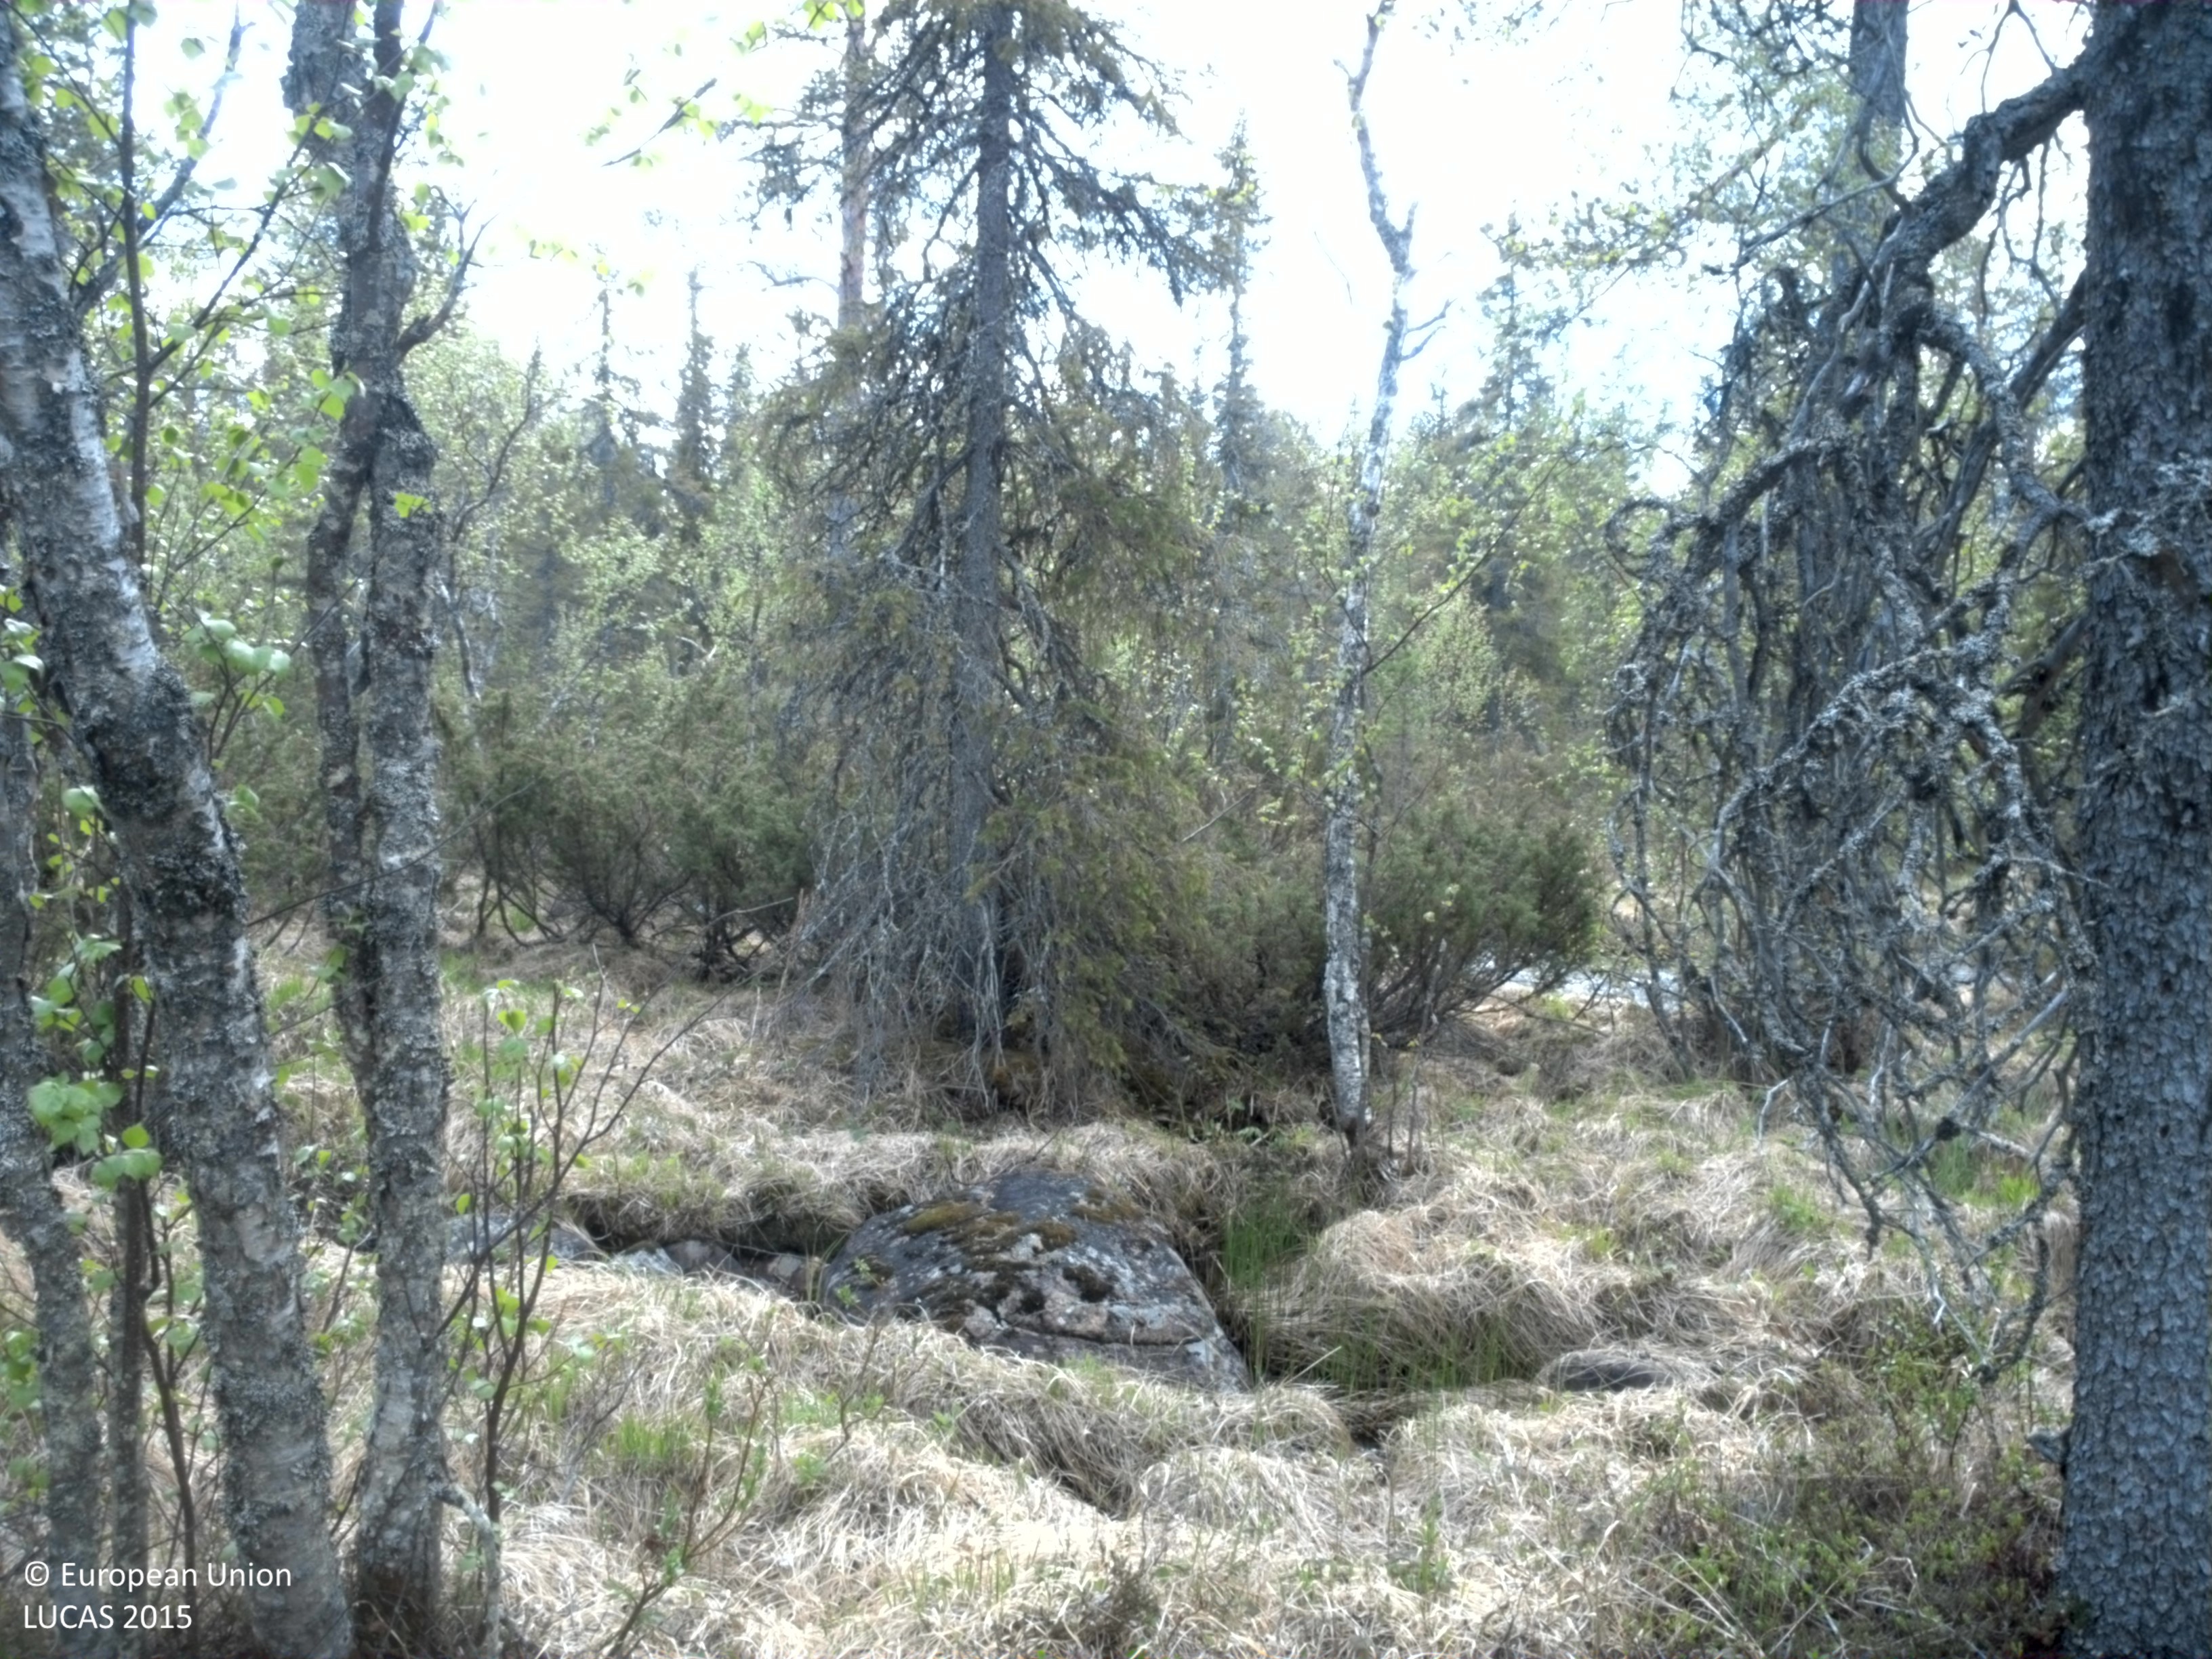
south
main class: Woodland
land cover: Pine dominated mixed woodland
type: boreal forest
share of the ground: 25 - 50 %
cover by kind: shrubs 55 %, coniferous forest trees 25 %, broadleaved forest trees 10 %, herbaceous plants 10 %
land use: Forestry
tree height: > 5 m
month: June
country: SE
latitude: 66.1028
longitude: 19.4469
